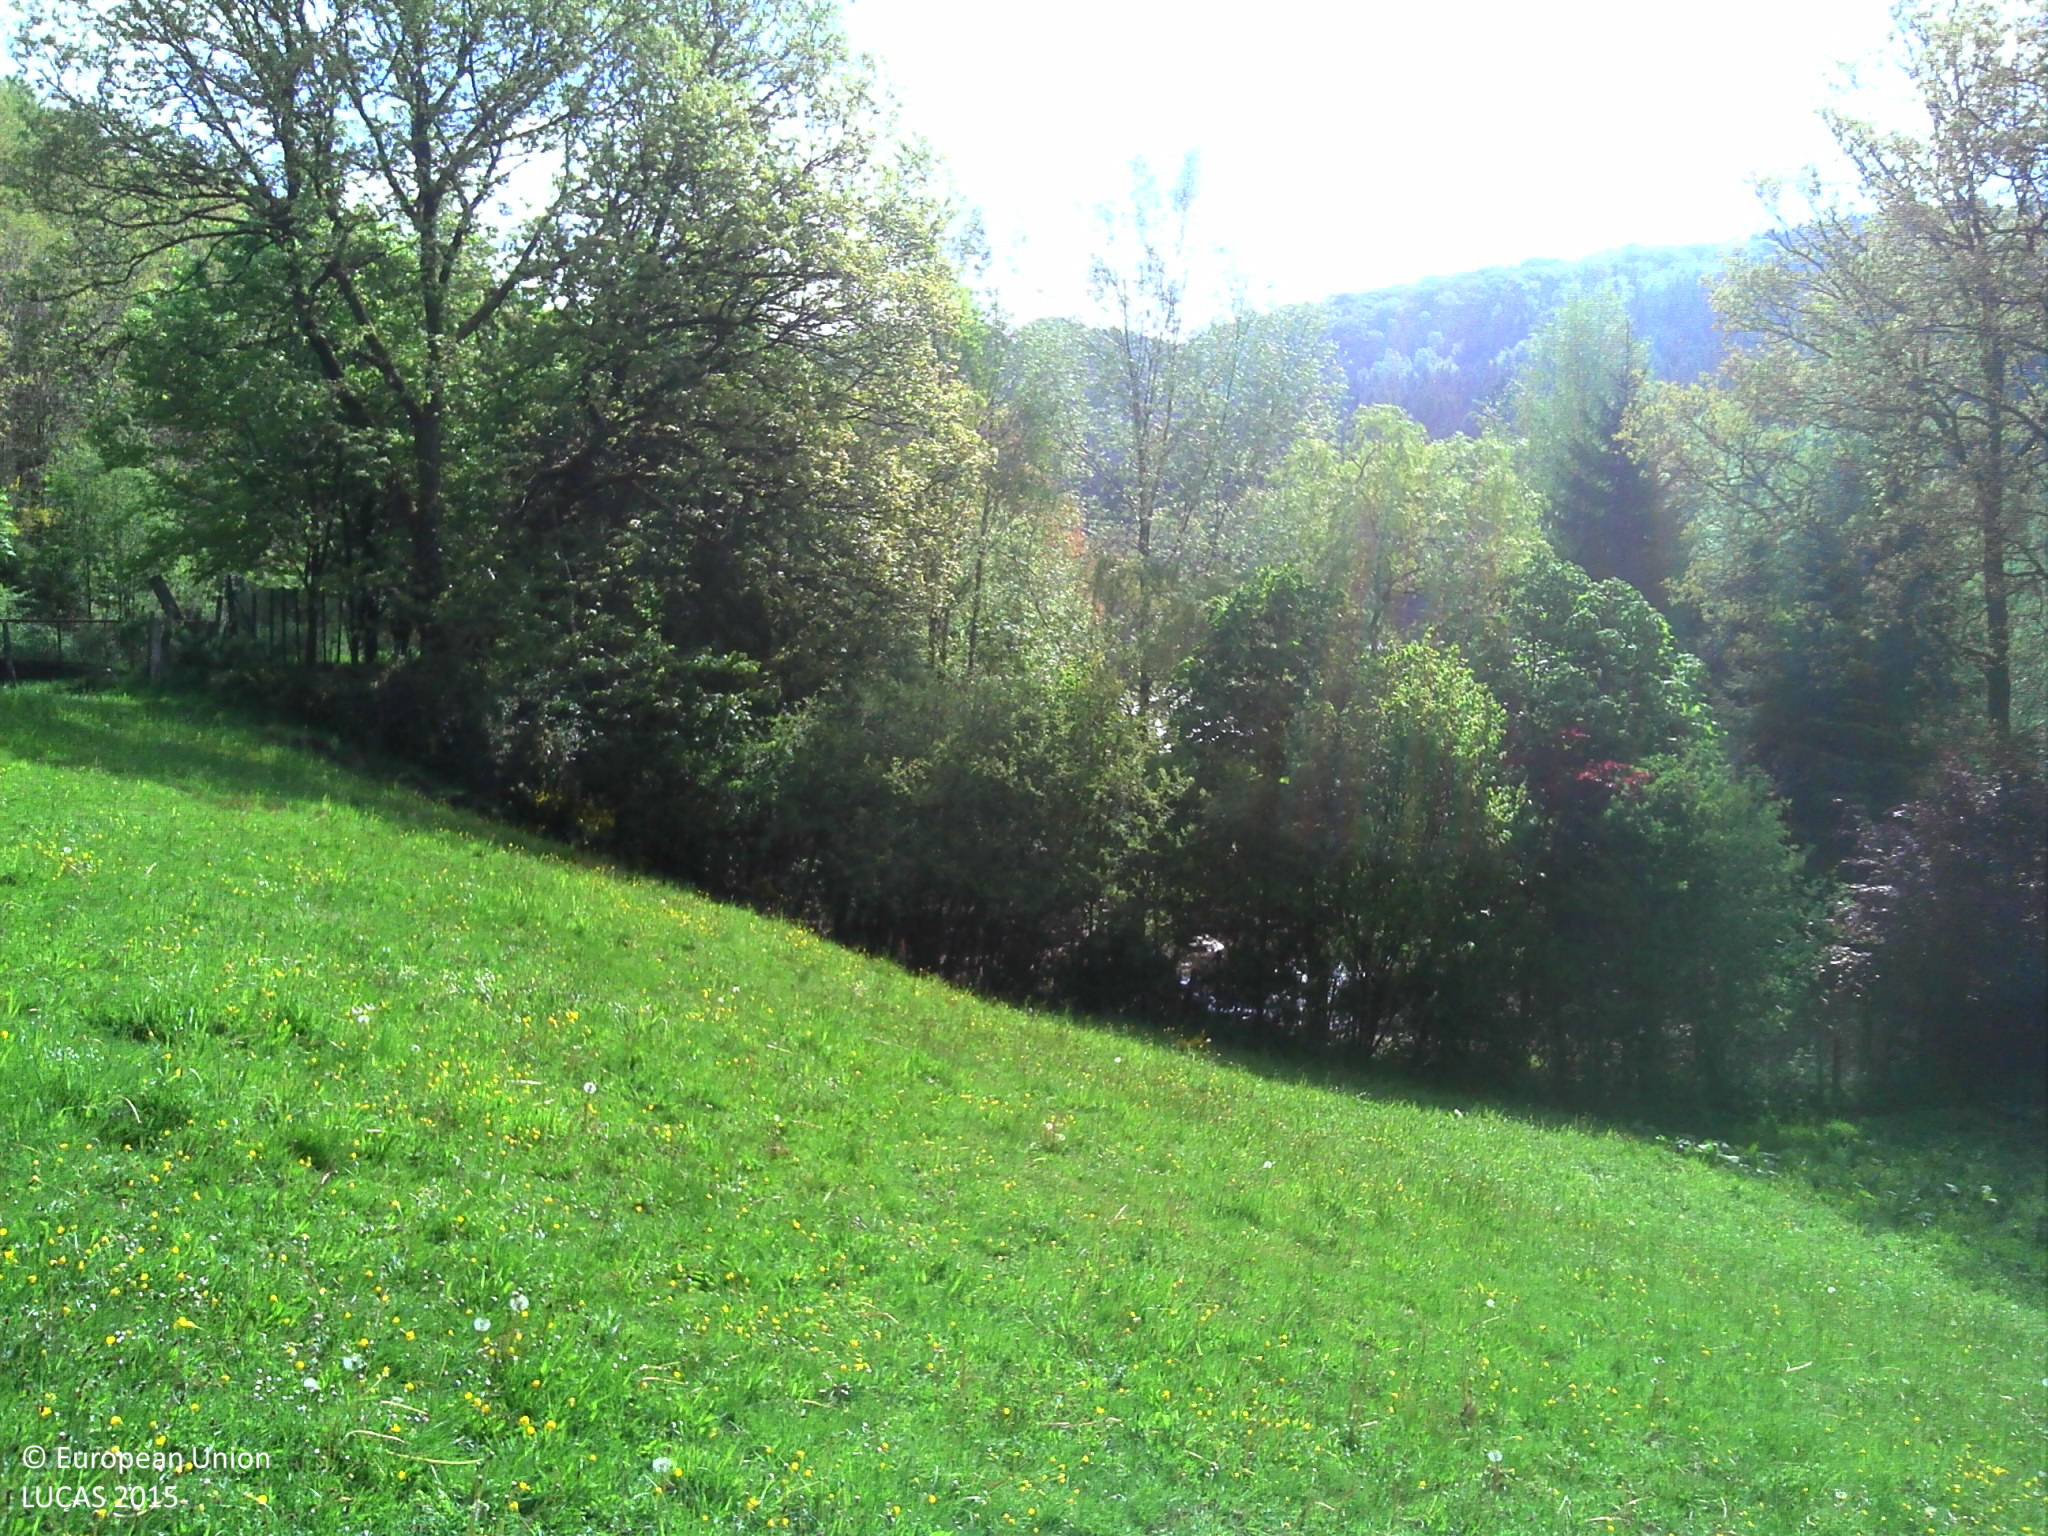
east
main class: Grassland
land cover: Grassland without tree/shrub cover
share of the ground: > 75 %
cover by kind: herbaceous plants 100 %
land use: Agriculture (excluding fallow land and kitchen gardens)
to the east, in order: Grassland without tree/shrub cover; Abandoned hedges; Fences; Ponds and wetlands; Fences; Broadleaved woodland; Tracks; Broadleaved woodland; Tracks; Grass margins; Managed hedges; Grassland without tree/shrub cover; Fences; Rivers and streams
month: May
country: LU
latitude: 50.0398
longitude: 5.9359
